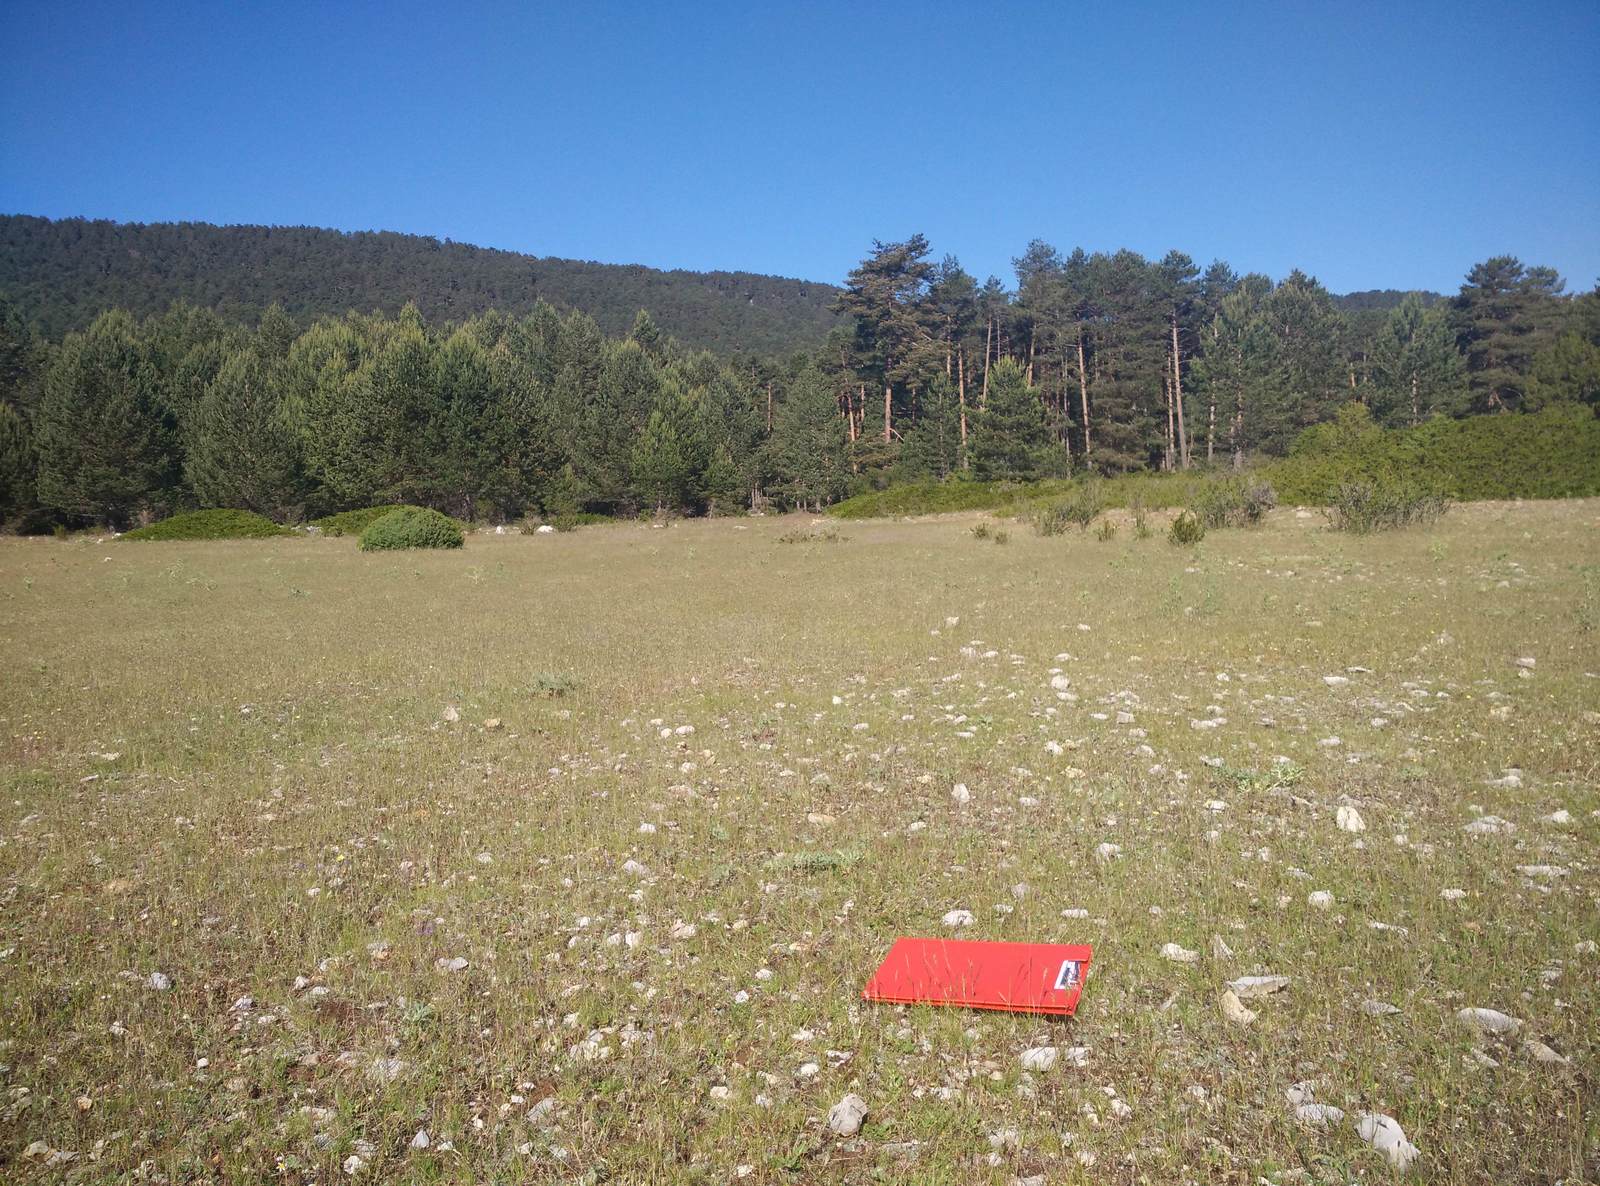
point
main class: Grassland
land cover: Grassland without tree/shrub cover
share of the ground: 50 - 75 %
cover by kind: herbaceous plants 70 %, consolidated bare surface 25 %, unconsolidated bare surface 5 %
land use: Agriculture (excluding fallow land and kitchen gardens)
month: June
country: ES
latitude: 40.3821
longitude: -1.7361
